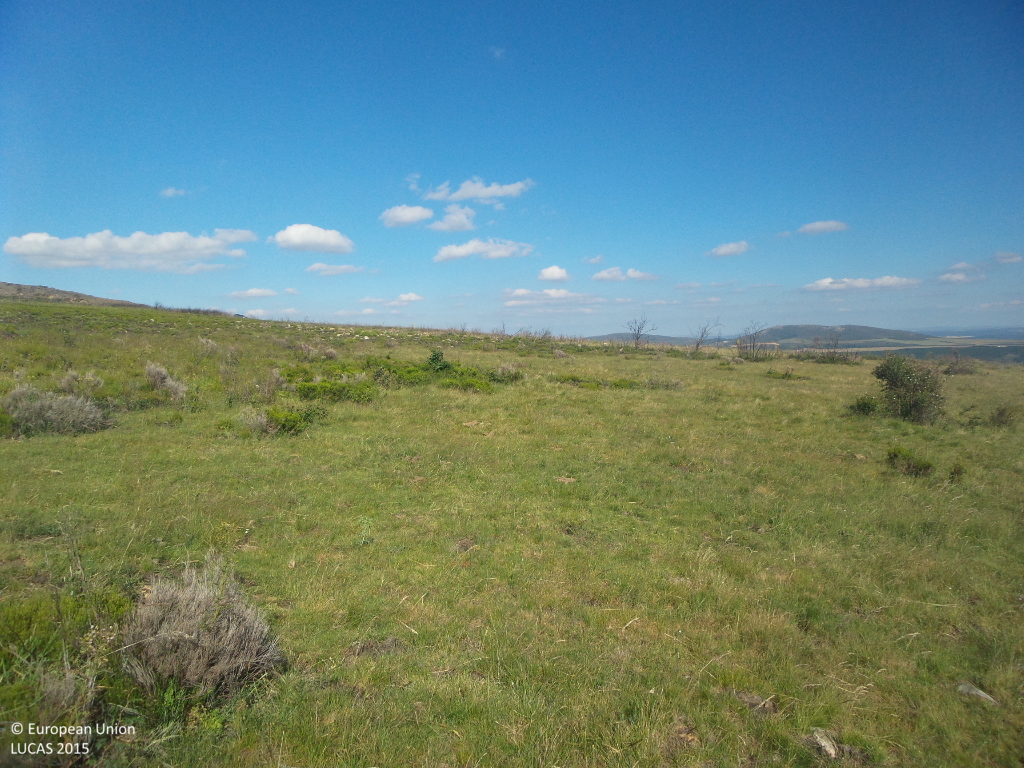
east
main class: Shrubland
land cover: Shrubland without tree cover
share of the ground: 25 - 50 %
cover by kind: herbaceous plants 50 %, shrubs 30 %, unconsolidated bare surface 20 %
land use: Semi-natural and natural areas not in use
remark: Burnt area
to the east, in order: Shrubland without tree cover
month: June
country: ES
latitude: 41.1494
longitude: -3.0377
